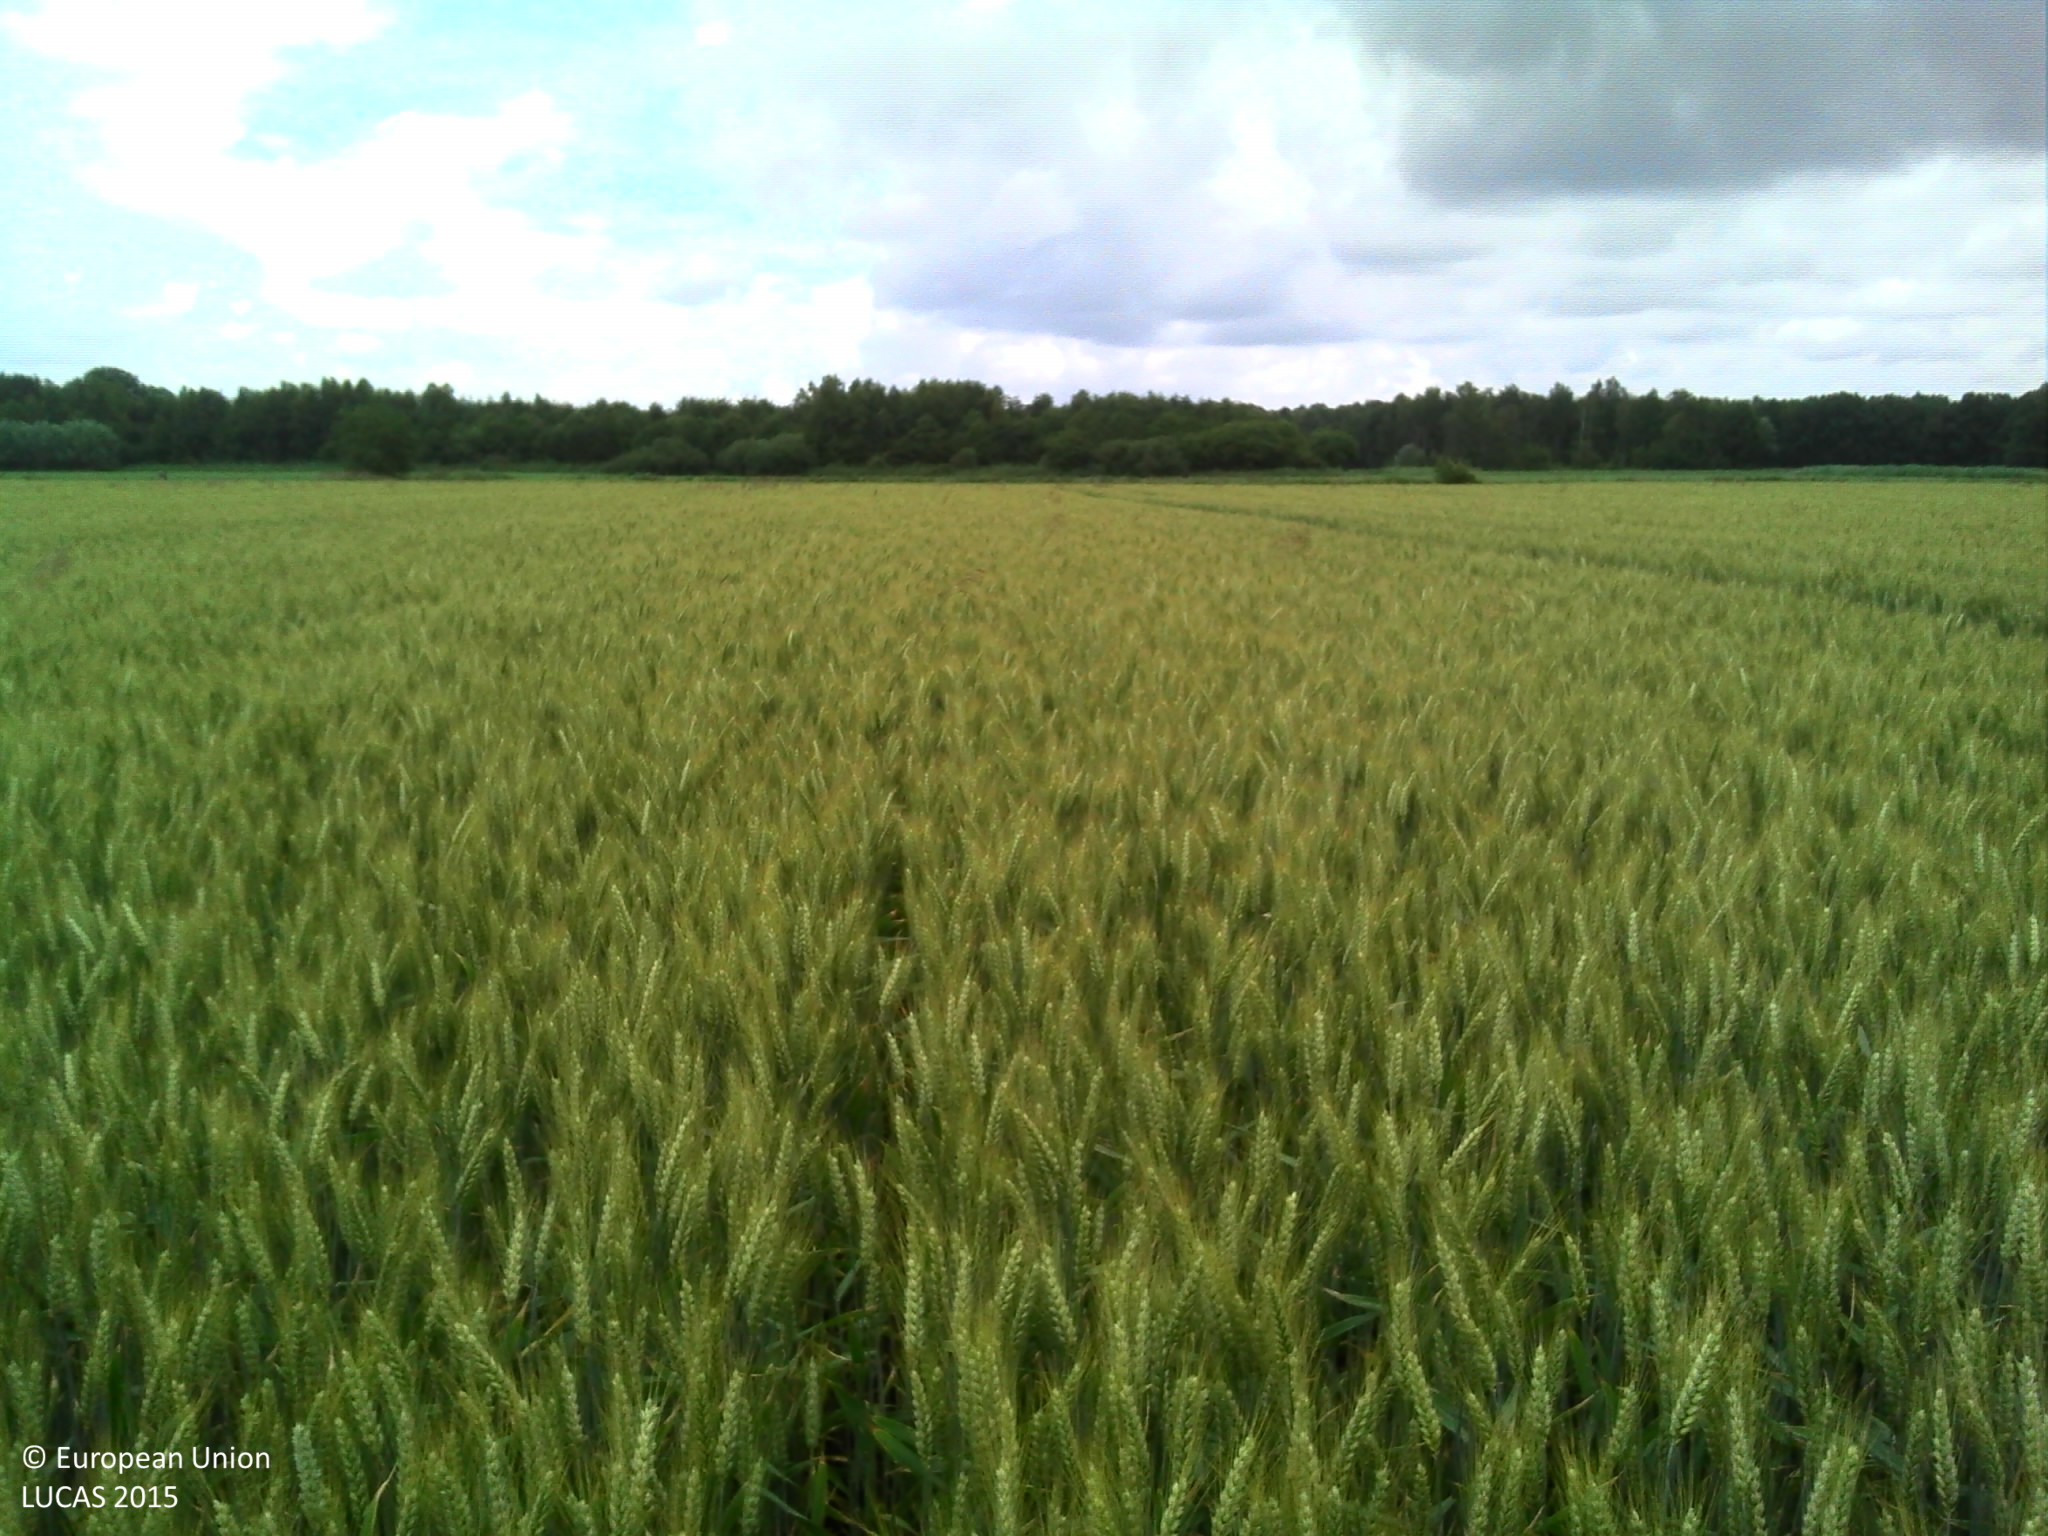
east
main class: Cropland
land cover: Common wheat
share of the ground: > 75 %
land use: Agriculture (excluding fallow land and kitchen gardens)
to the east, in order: Common wheat; Grass margins; Ditches and canals; Grass margins; Maize; Grass margins; Ditches and canals; Grass margins; Maize; Grass margins; Ditches and canals; Grass margins; Maize
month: June
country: BE
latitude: 51.1981
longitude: 3.9979
